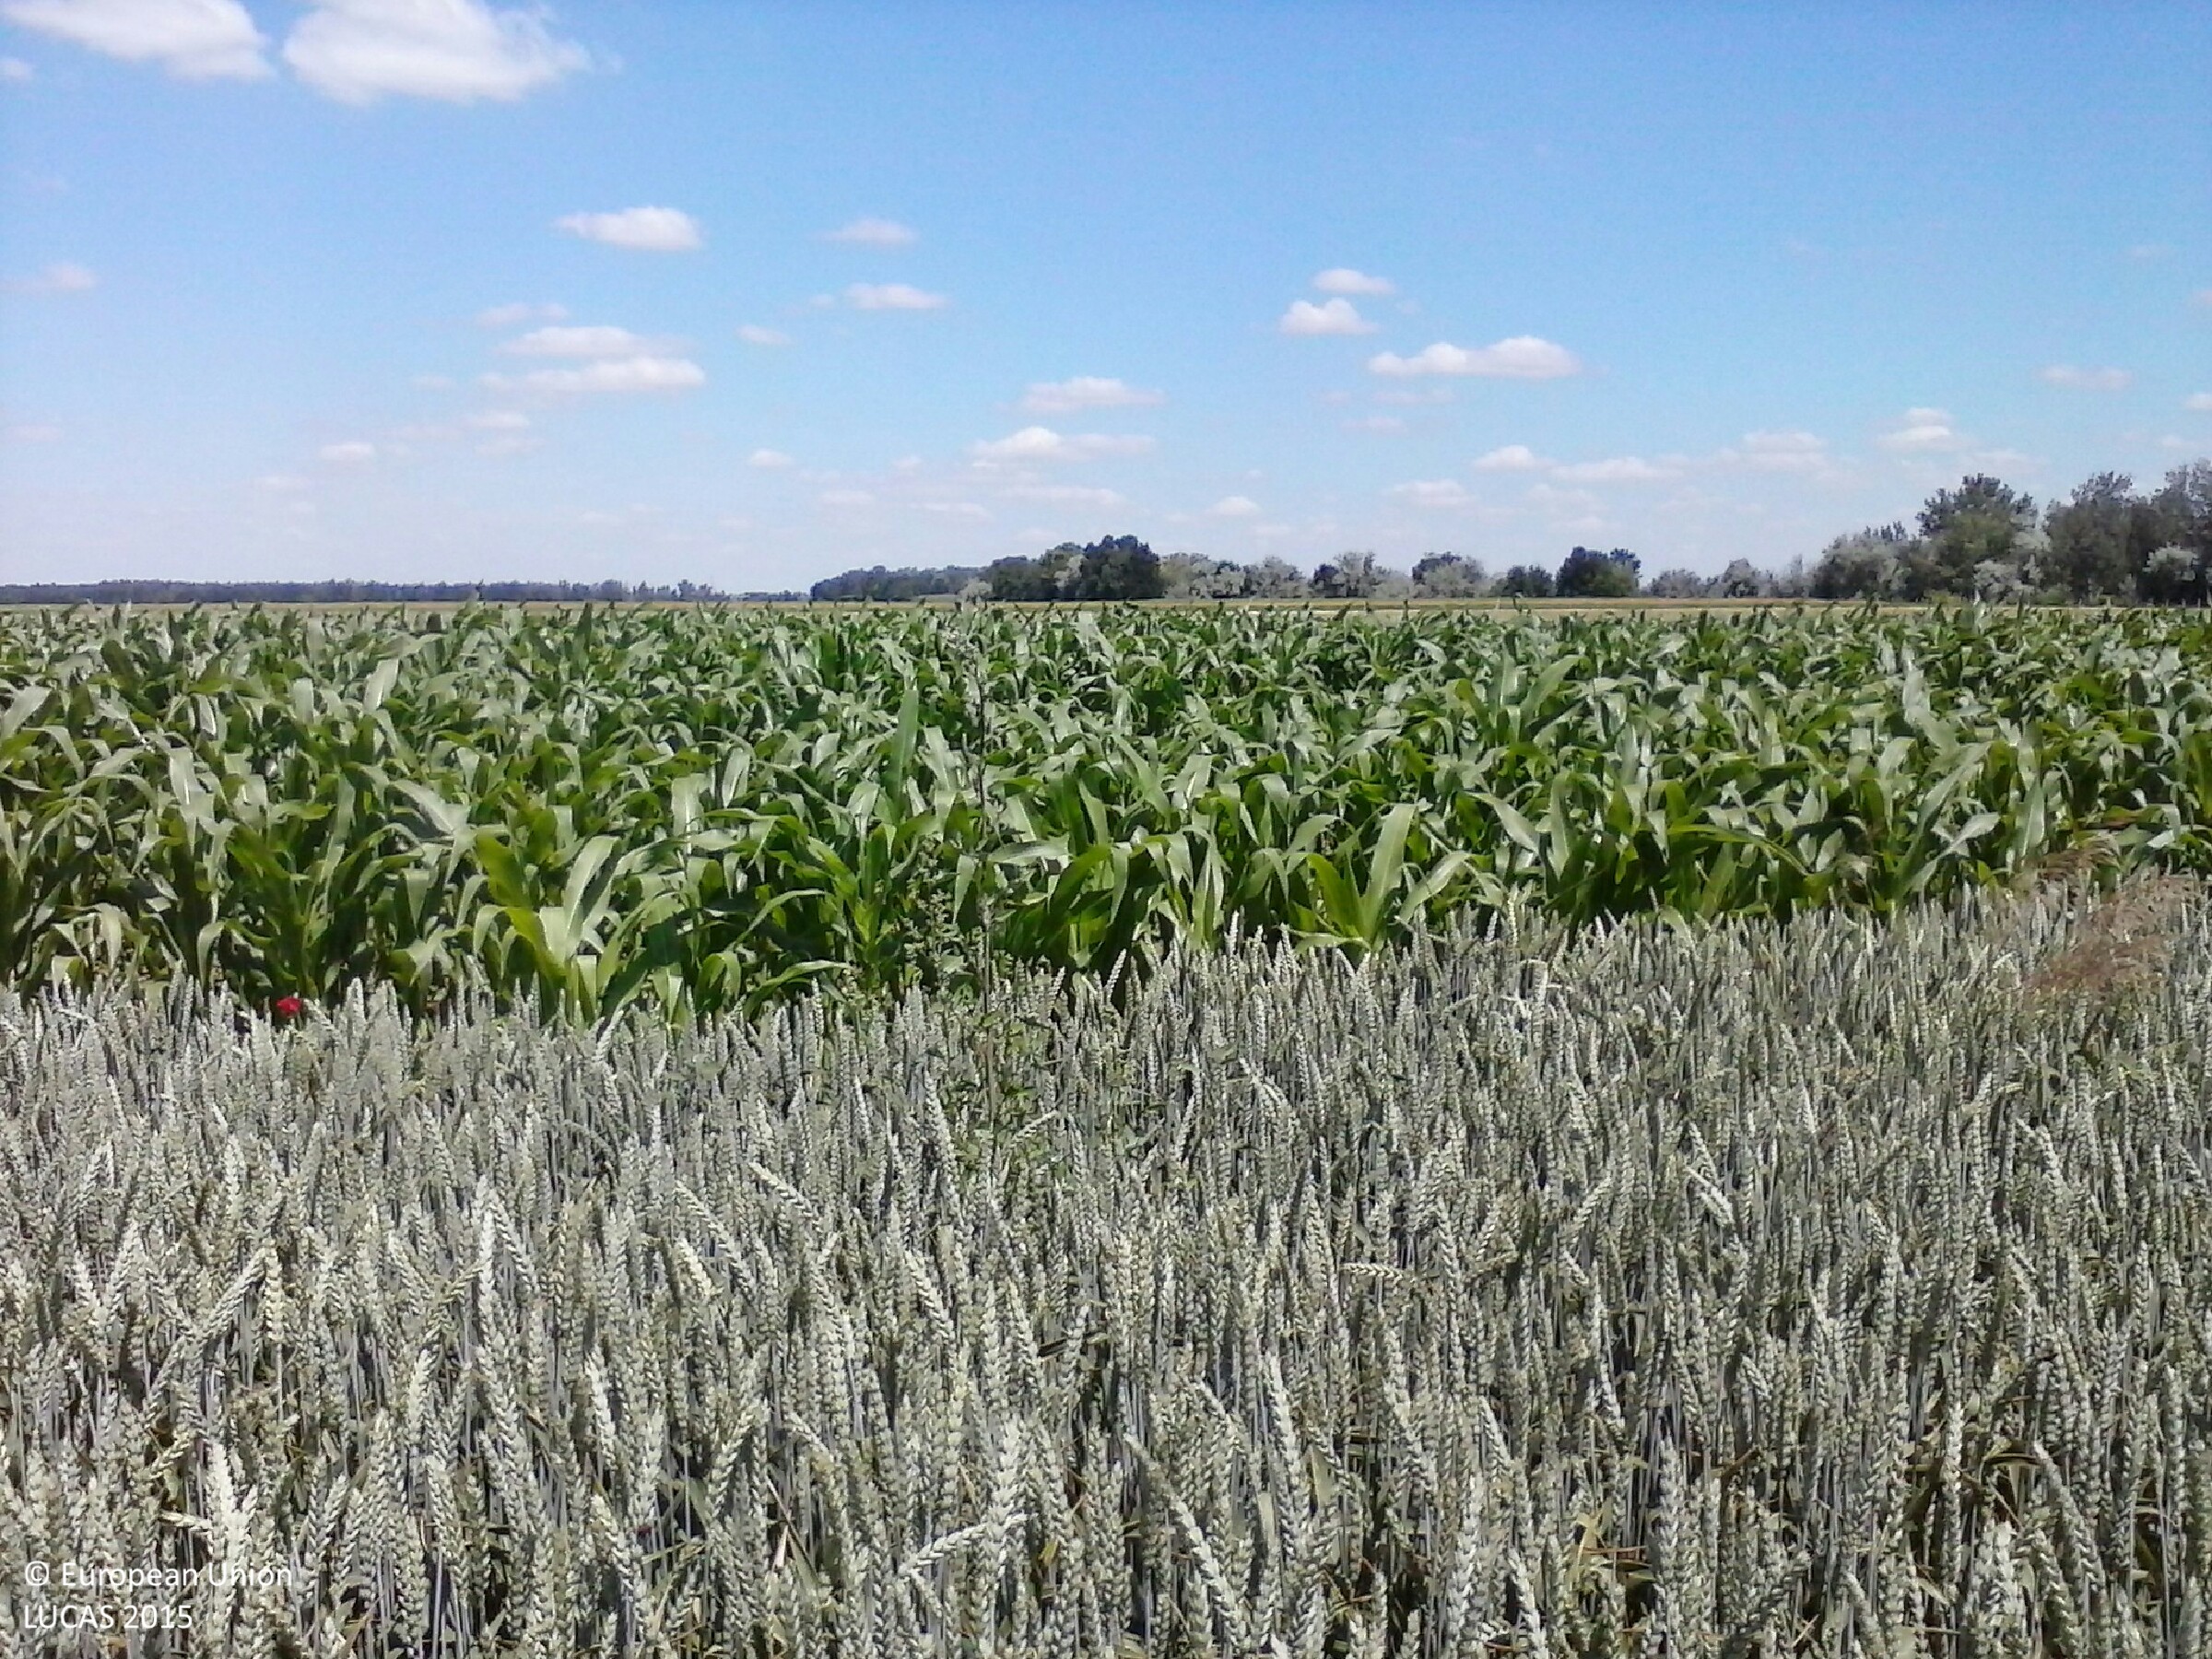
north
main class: Cropland
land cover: Common wheat
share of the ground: > 75 %
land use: Agriculture (excluding fallow land and kitchen gardens)
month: June
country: HU
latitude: 46.2376
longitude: 20.0714
